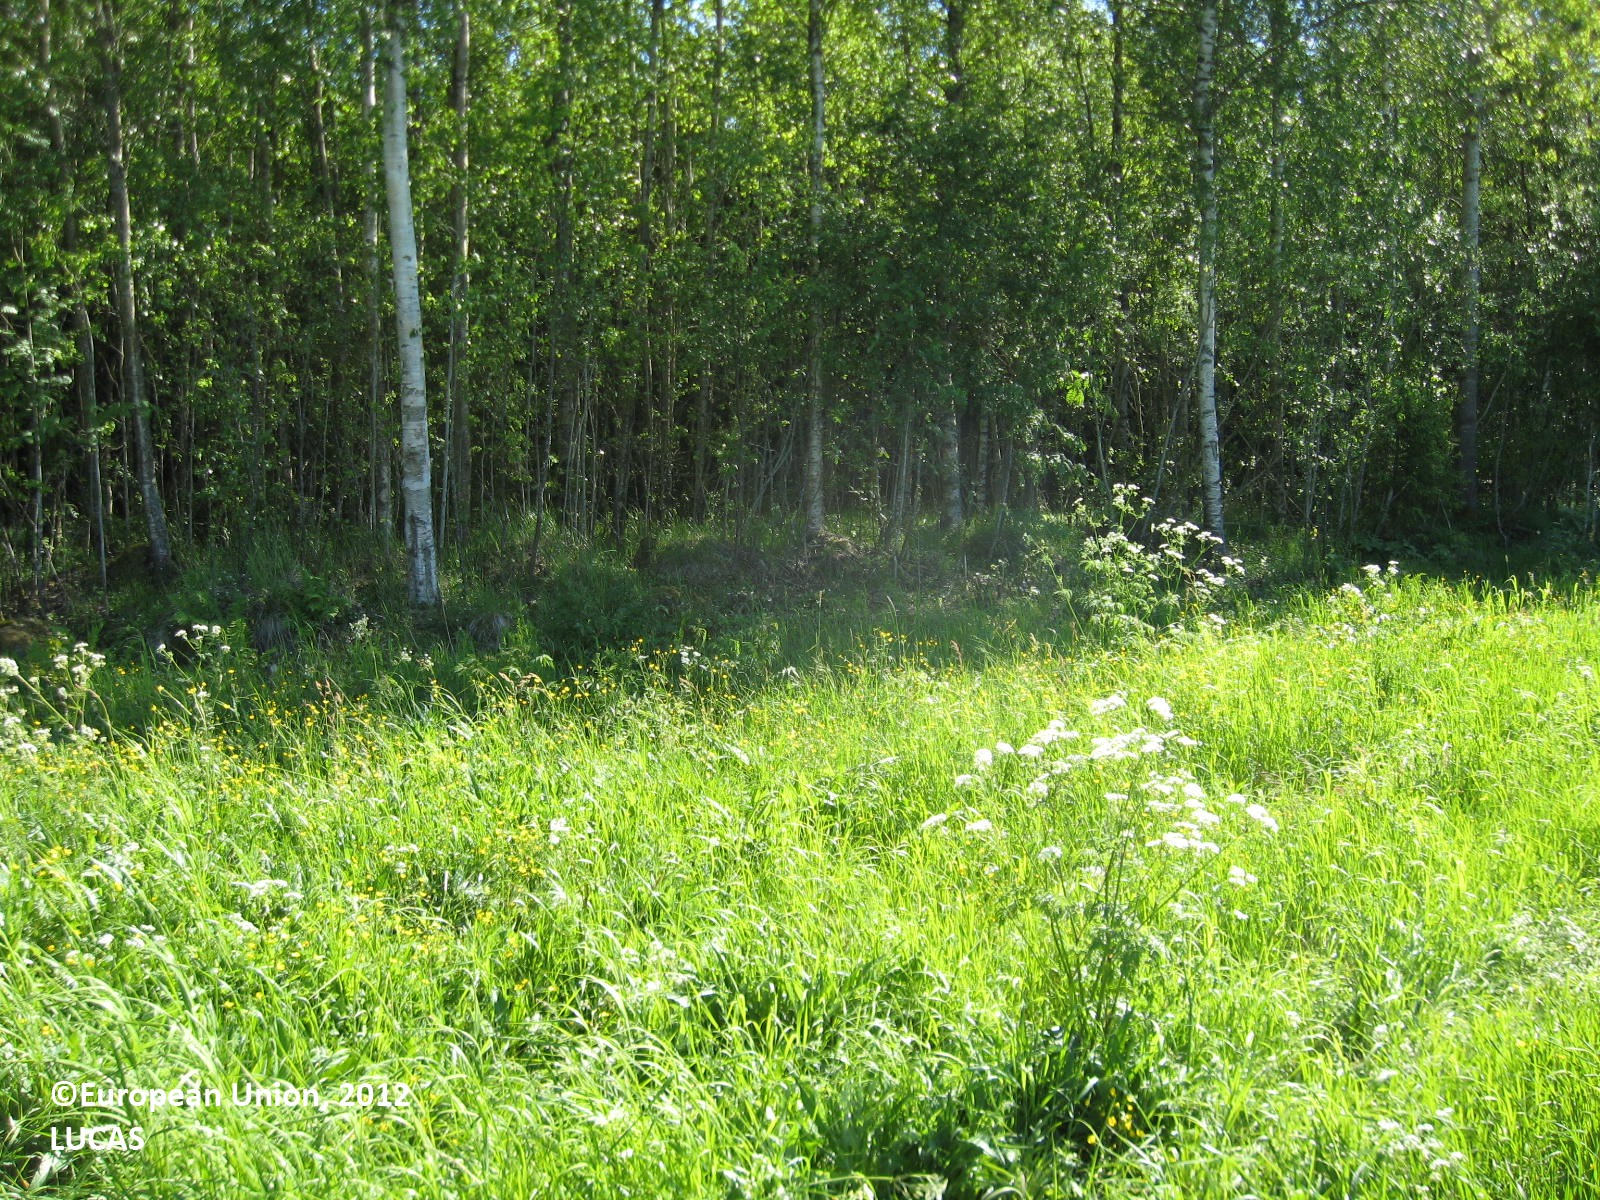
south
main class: Grassland
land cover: Spontaneously vegetated surfaces
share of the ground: > 75 %
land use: Fallow land
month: June
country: FI
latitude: 62.7368
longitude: 21.2513
